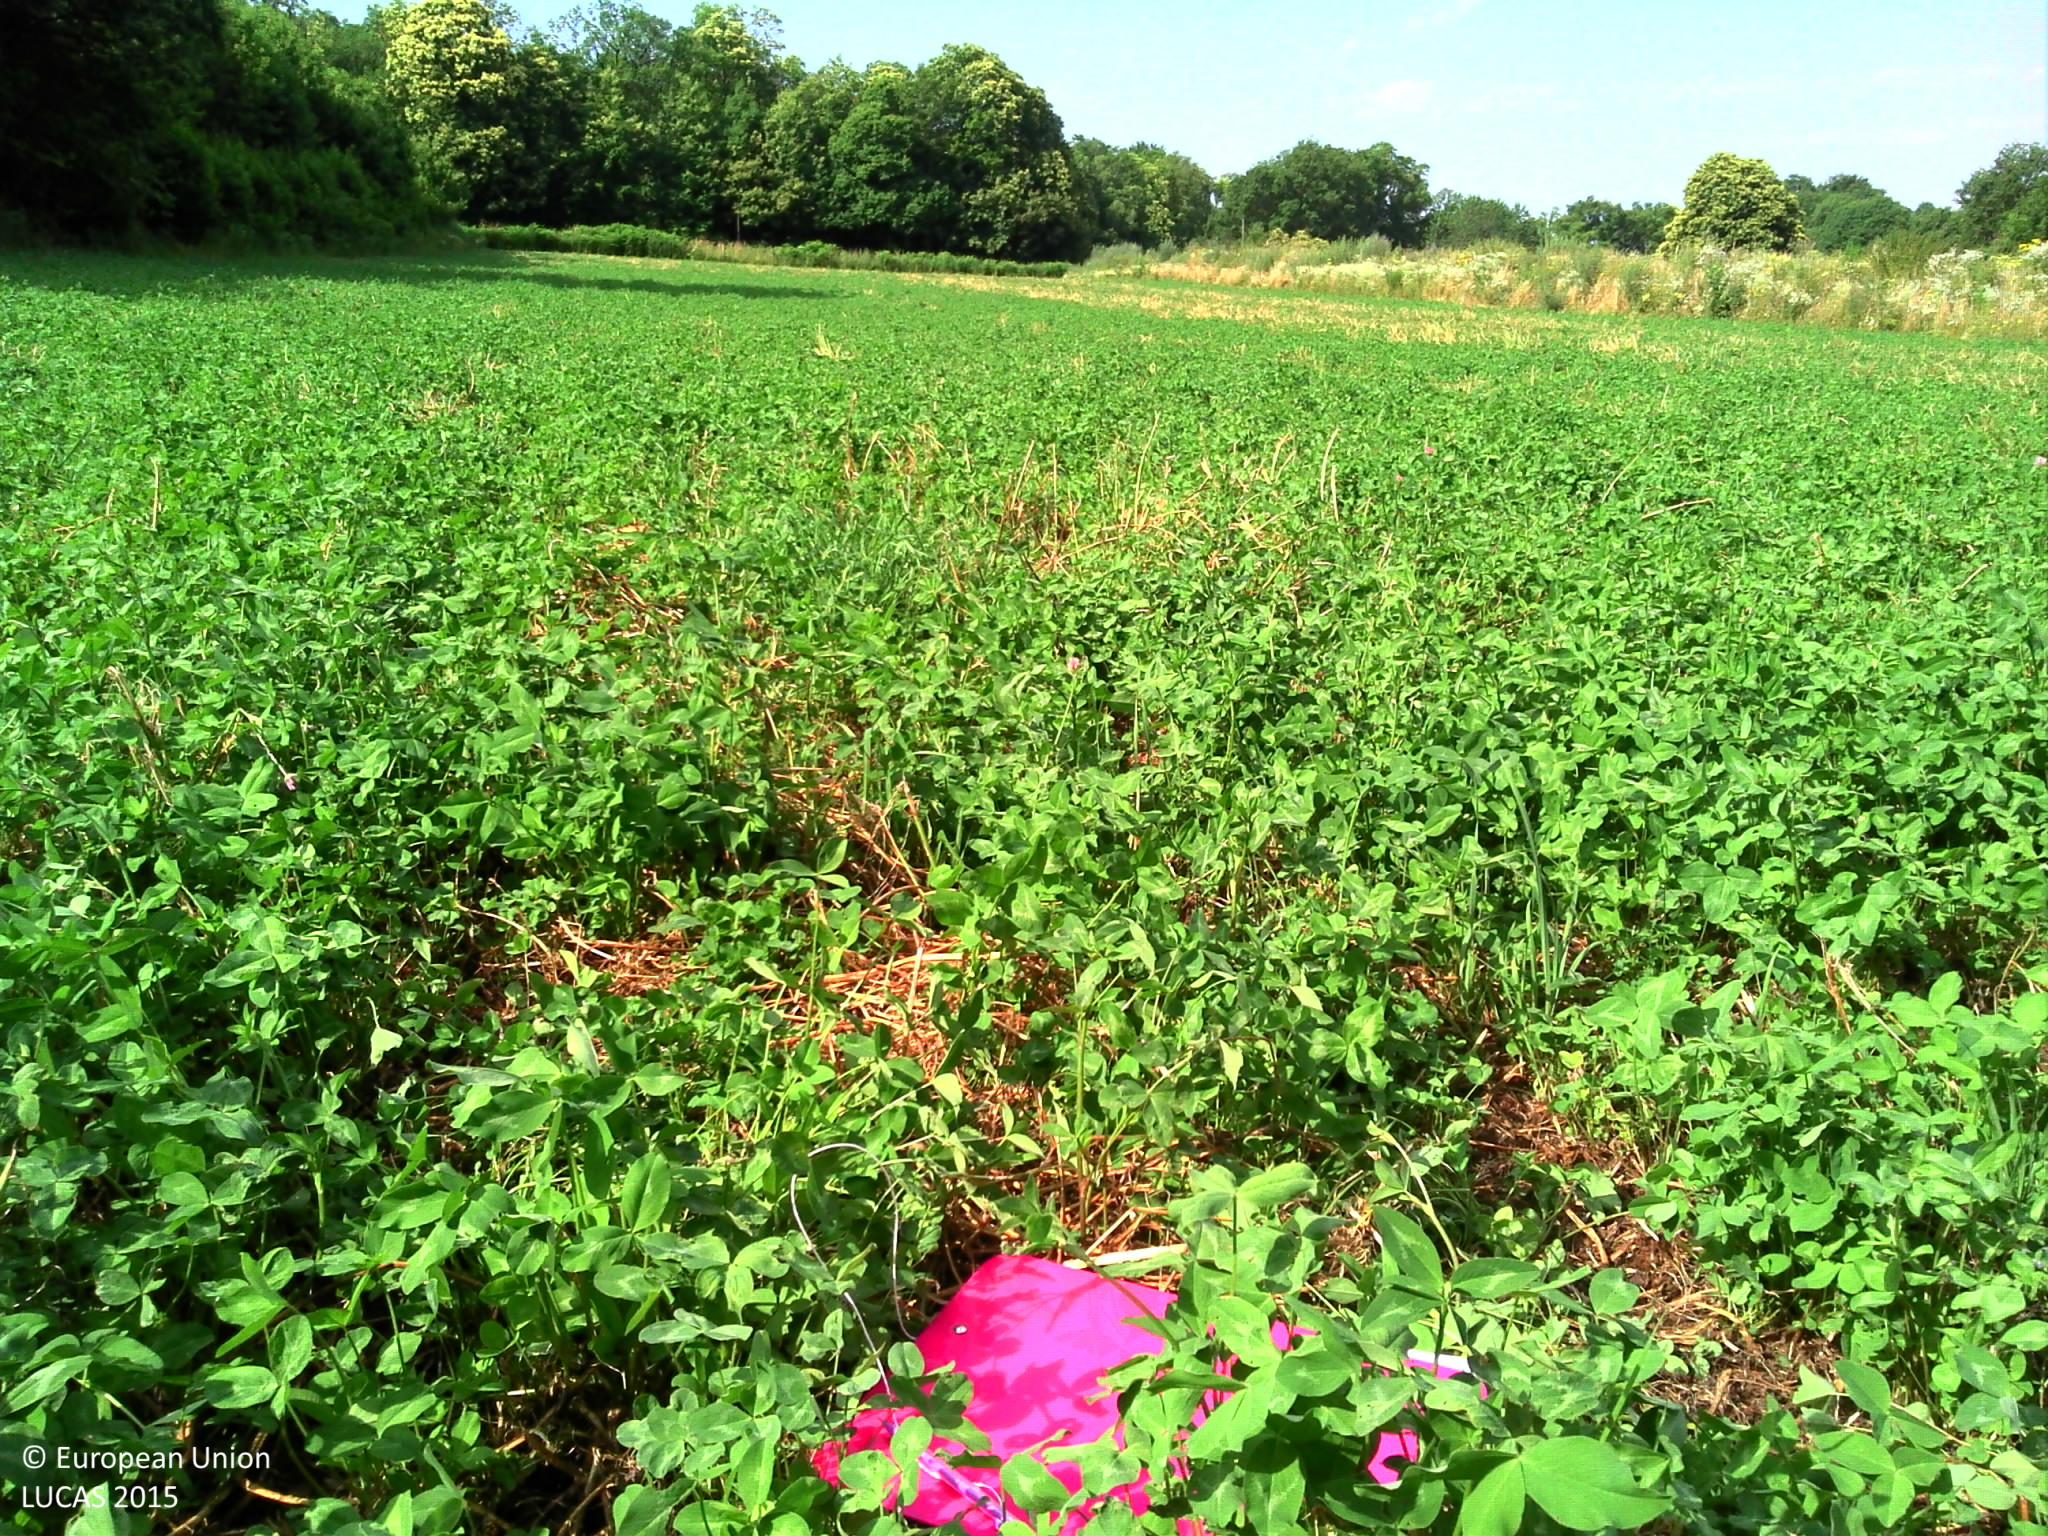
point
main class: Cropland
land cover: Clovers
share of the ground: > 75 %
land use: Agriculture (excluding fallow land and kitchen gardens)
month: July
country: FR
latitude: 46.0940
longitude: 1.3892
